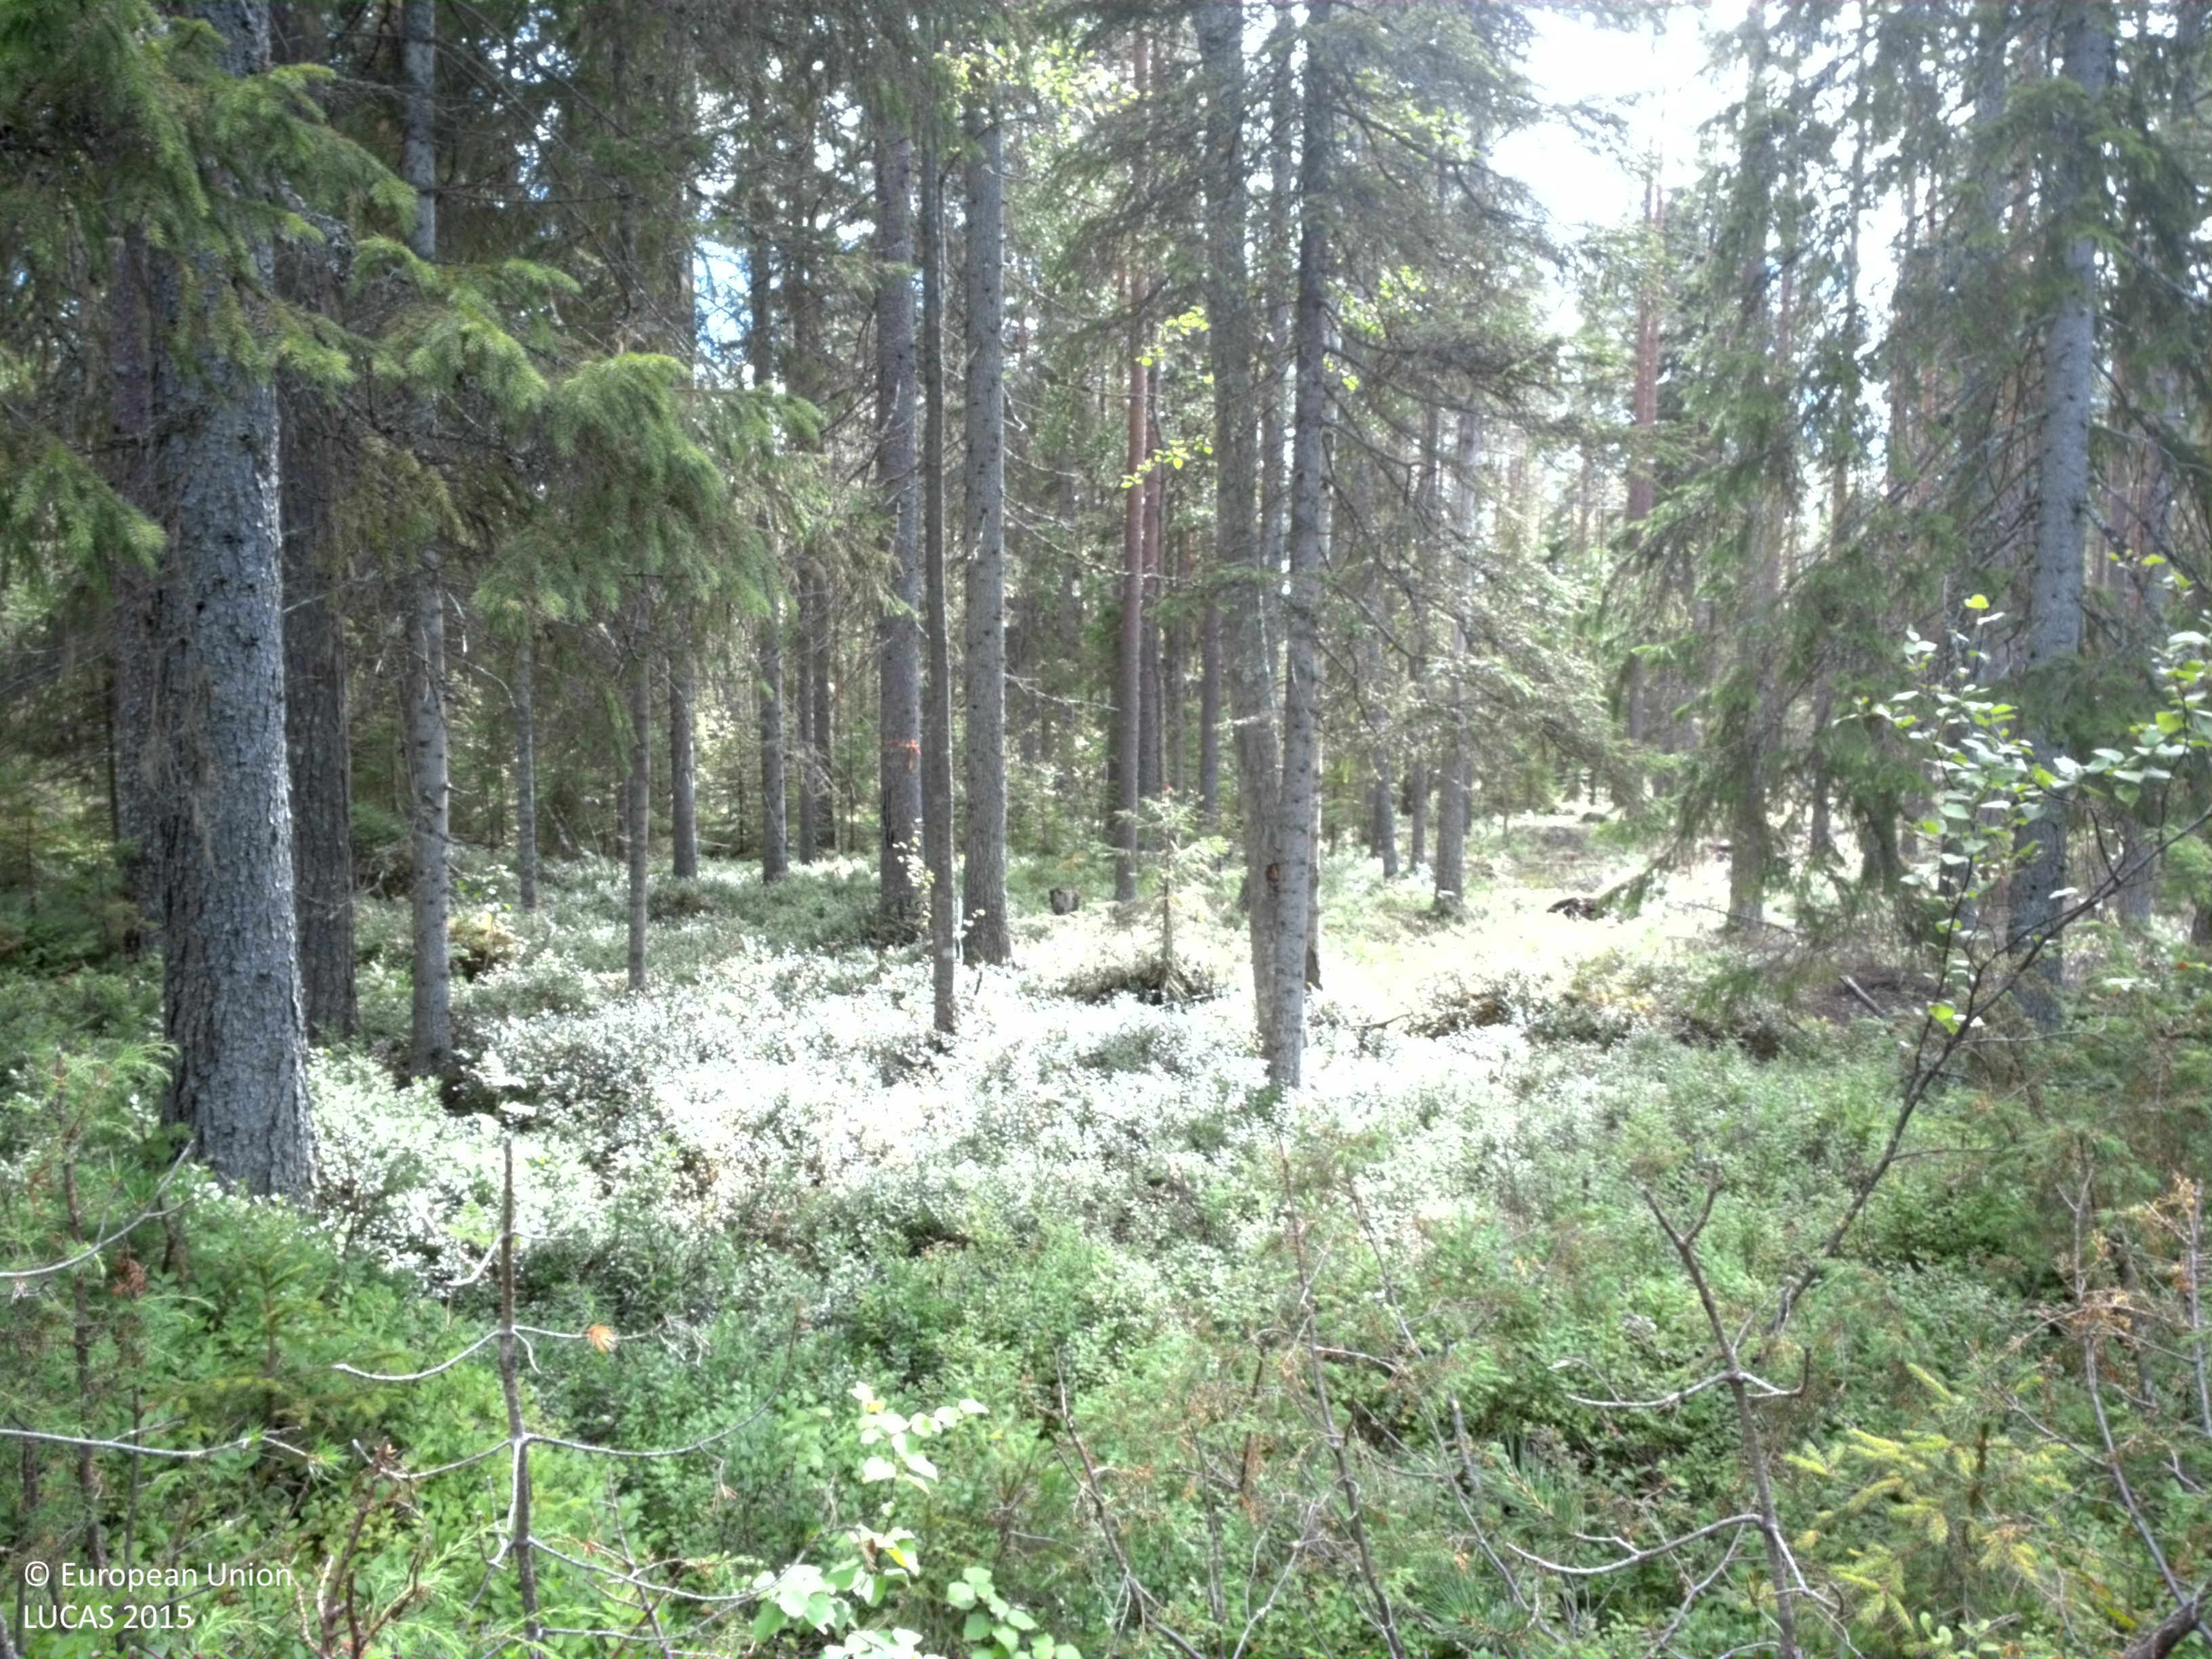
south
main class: Woodland
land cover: Other mixed woodland
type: boreal forest
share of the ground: 50 - 75 %
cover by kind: coniferous forest trees 45 %, shrubs 40 %, broadleaved forest trees 15 %
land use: Forestry
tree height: > 5 m
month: August
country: SE
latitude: 64.6263
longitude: 20.8754
